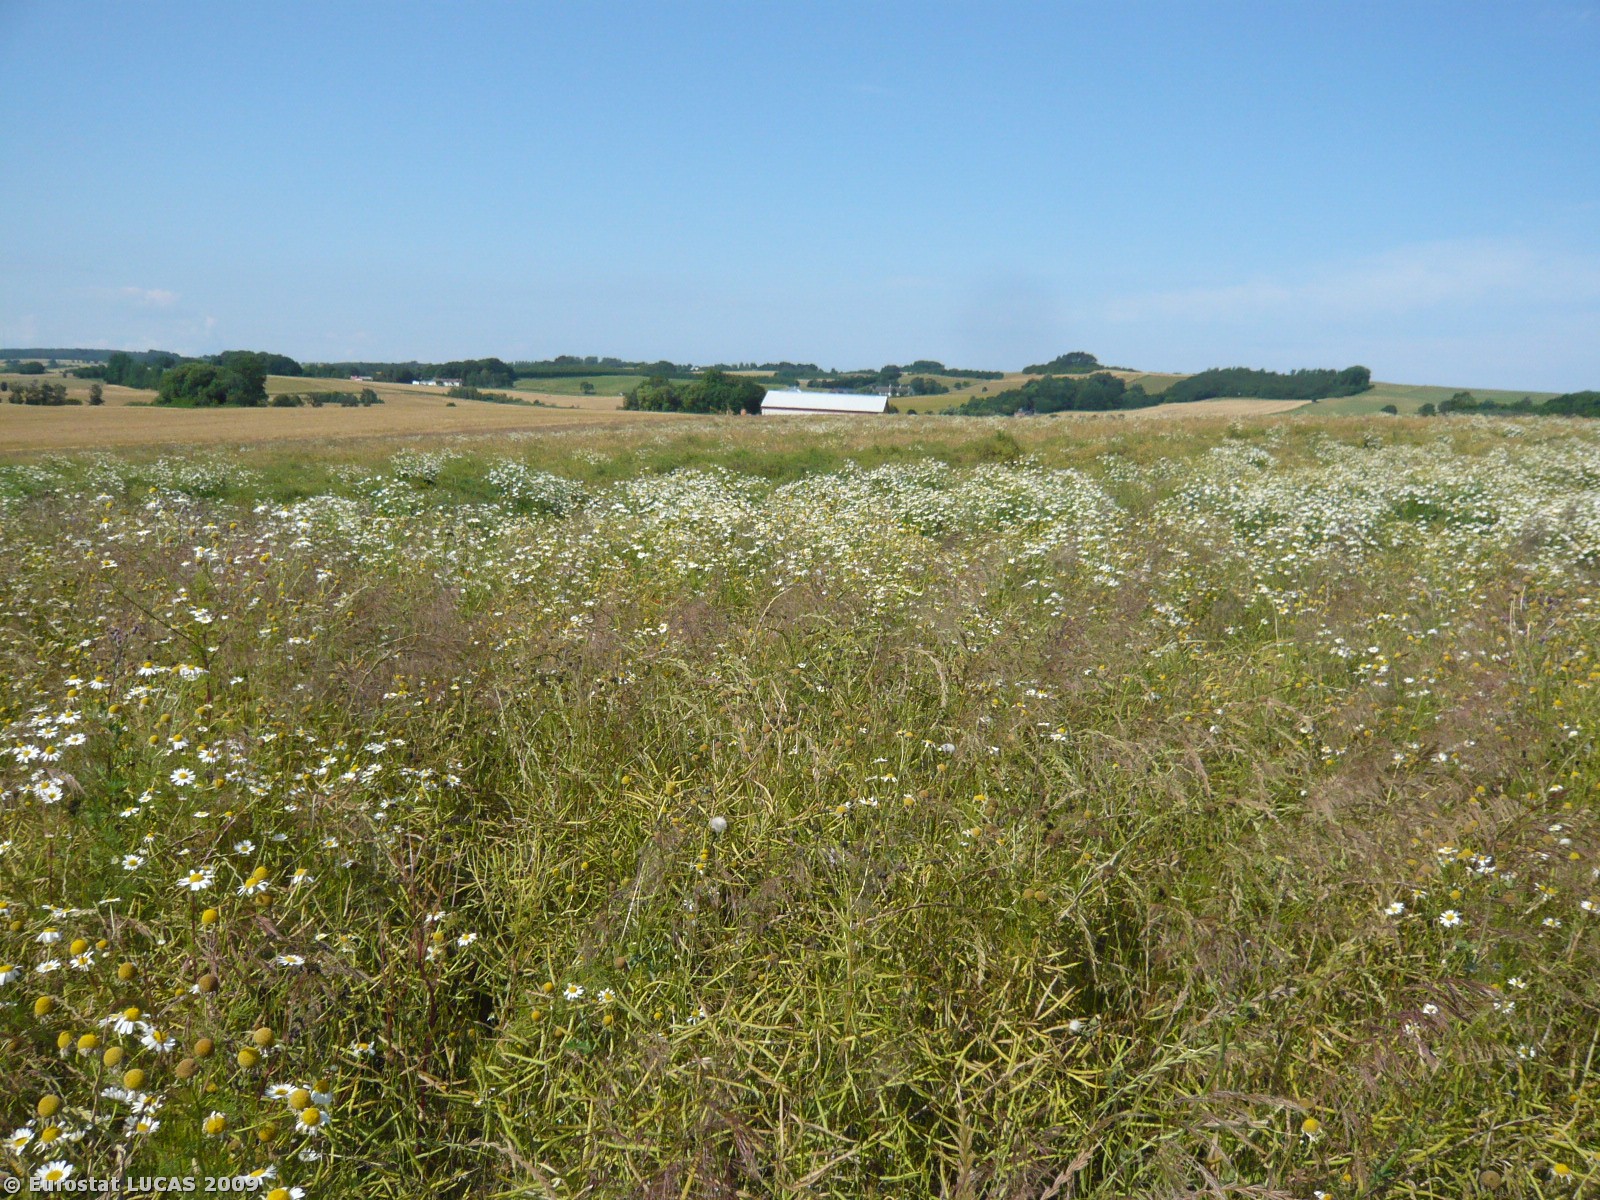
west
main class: Cropland
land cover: Rape and turnip rape
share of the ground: > 75 %
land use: Agriculture (excluding fallow land and kitchen gardens)
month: July
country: DK
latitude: 55.8200
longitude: 11.4510
